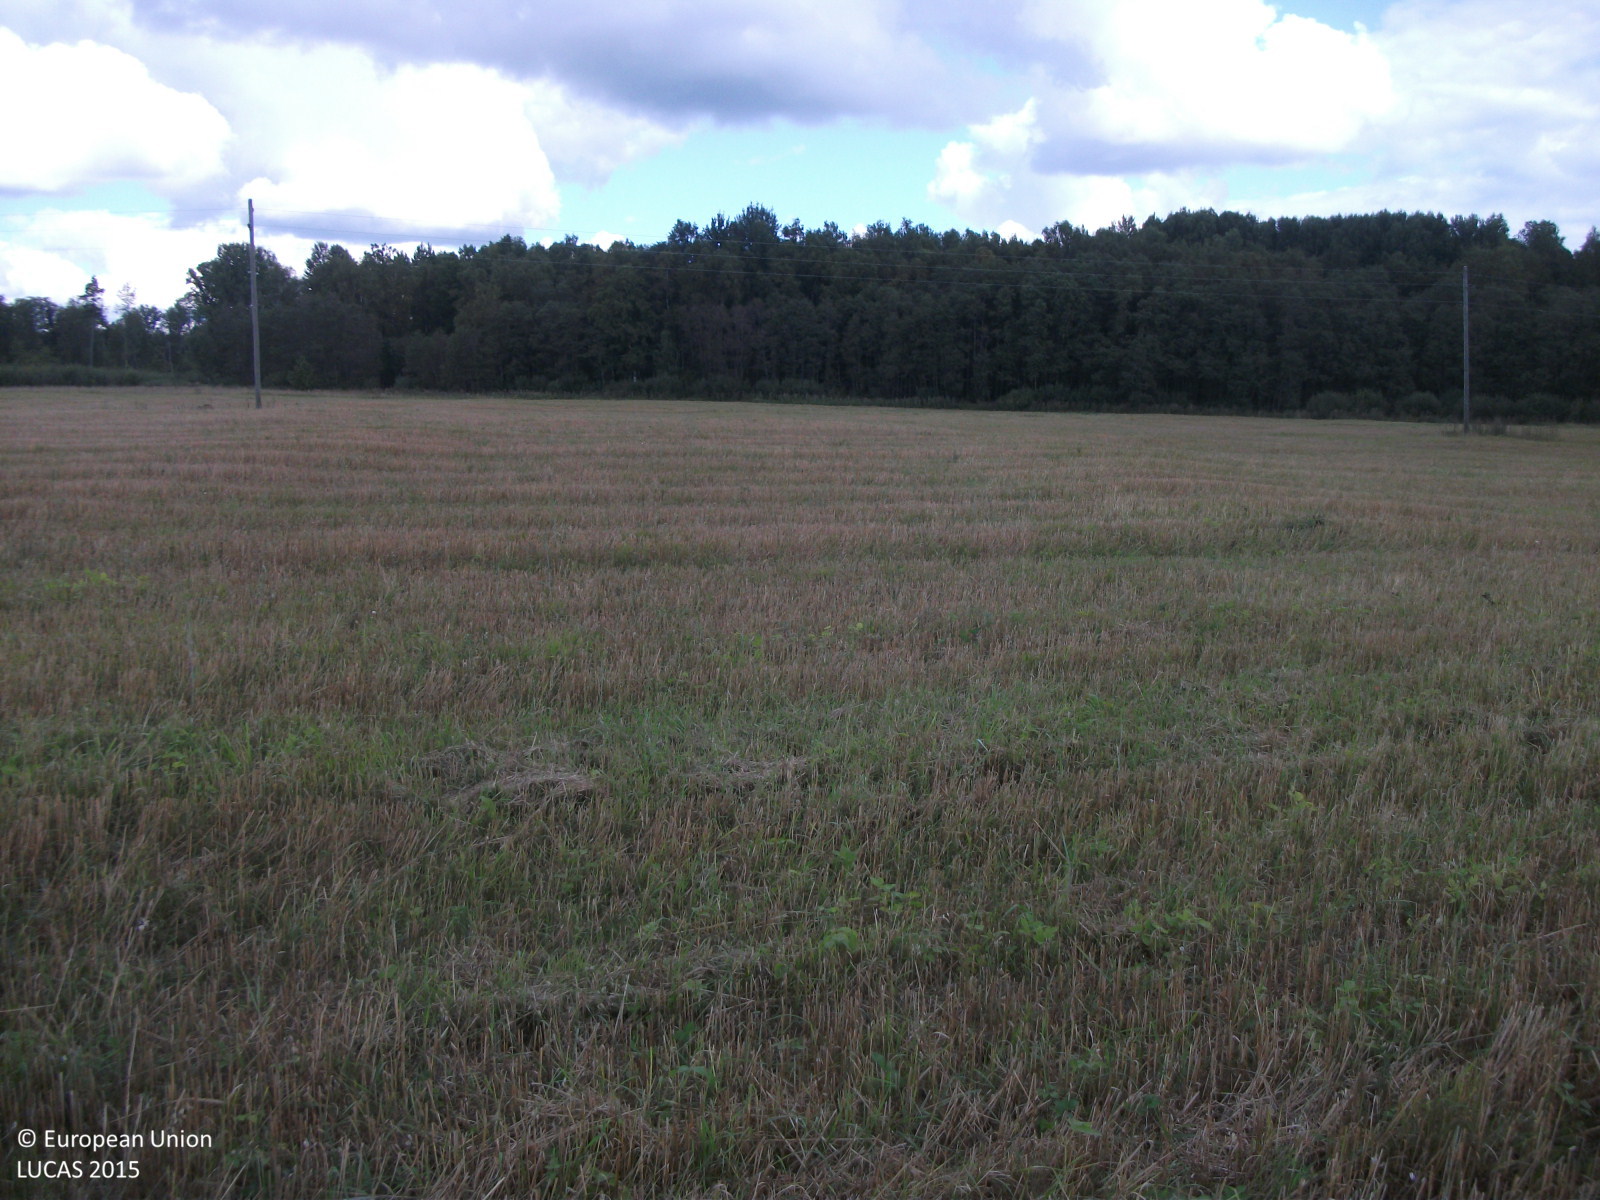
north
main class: Cropland
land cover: Common wheat
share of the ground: < 10 %
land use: Agriculture (excluding fallow land and kitchen gardens)
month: September
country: LV
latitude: 57.4589
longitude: 24.5438
